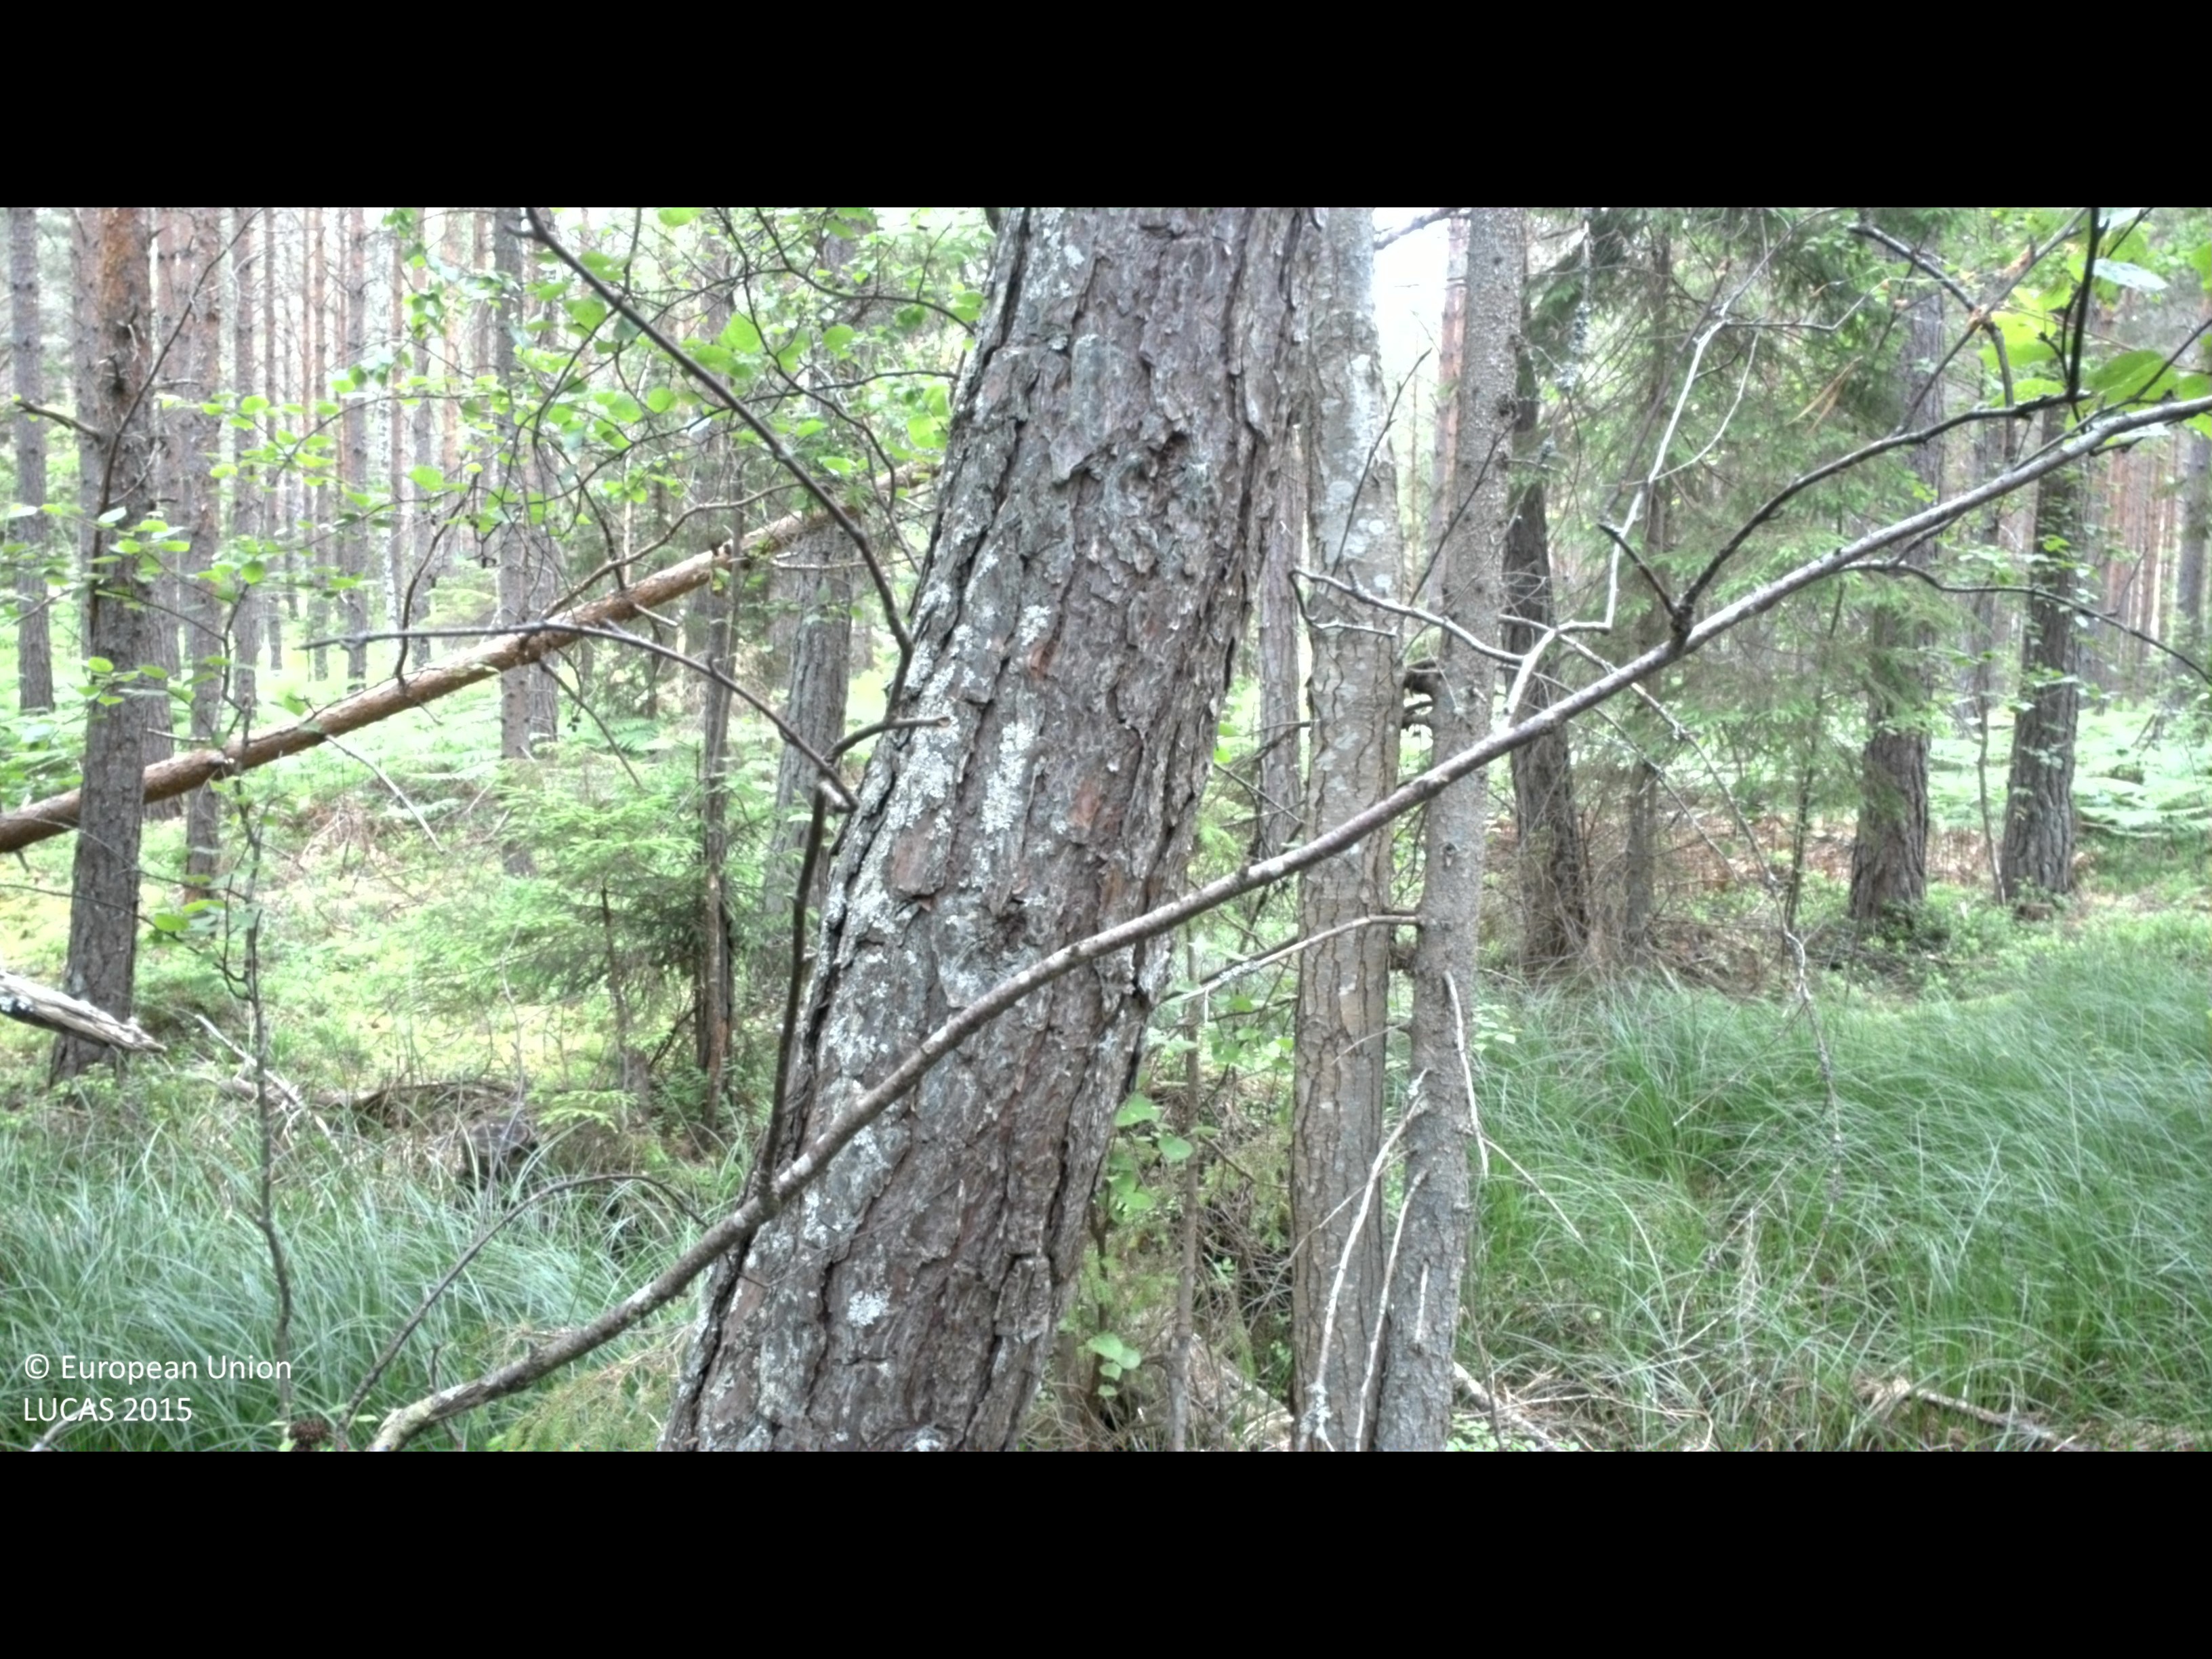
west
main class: Woodland
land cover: Pine dominated mixed woodland
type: boreal forest
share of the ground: > 75 %
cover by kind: coniferous forest trees 50 %, broadleaved forest trees 25 %, shrubs 15 %, herbaceous plants 5 %, lichens and mosses 5 %
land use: Forestry
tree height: > 5 m
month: June
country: SE
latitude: 57.9684
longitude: 16.5738
